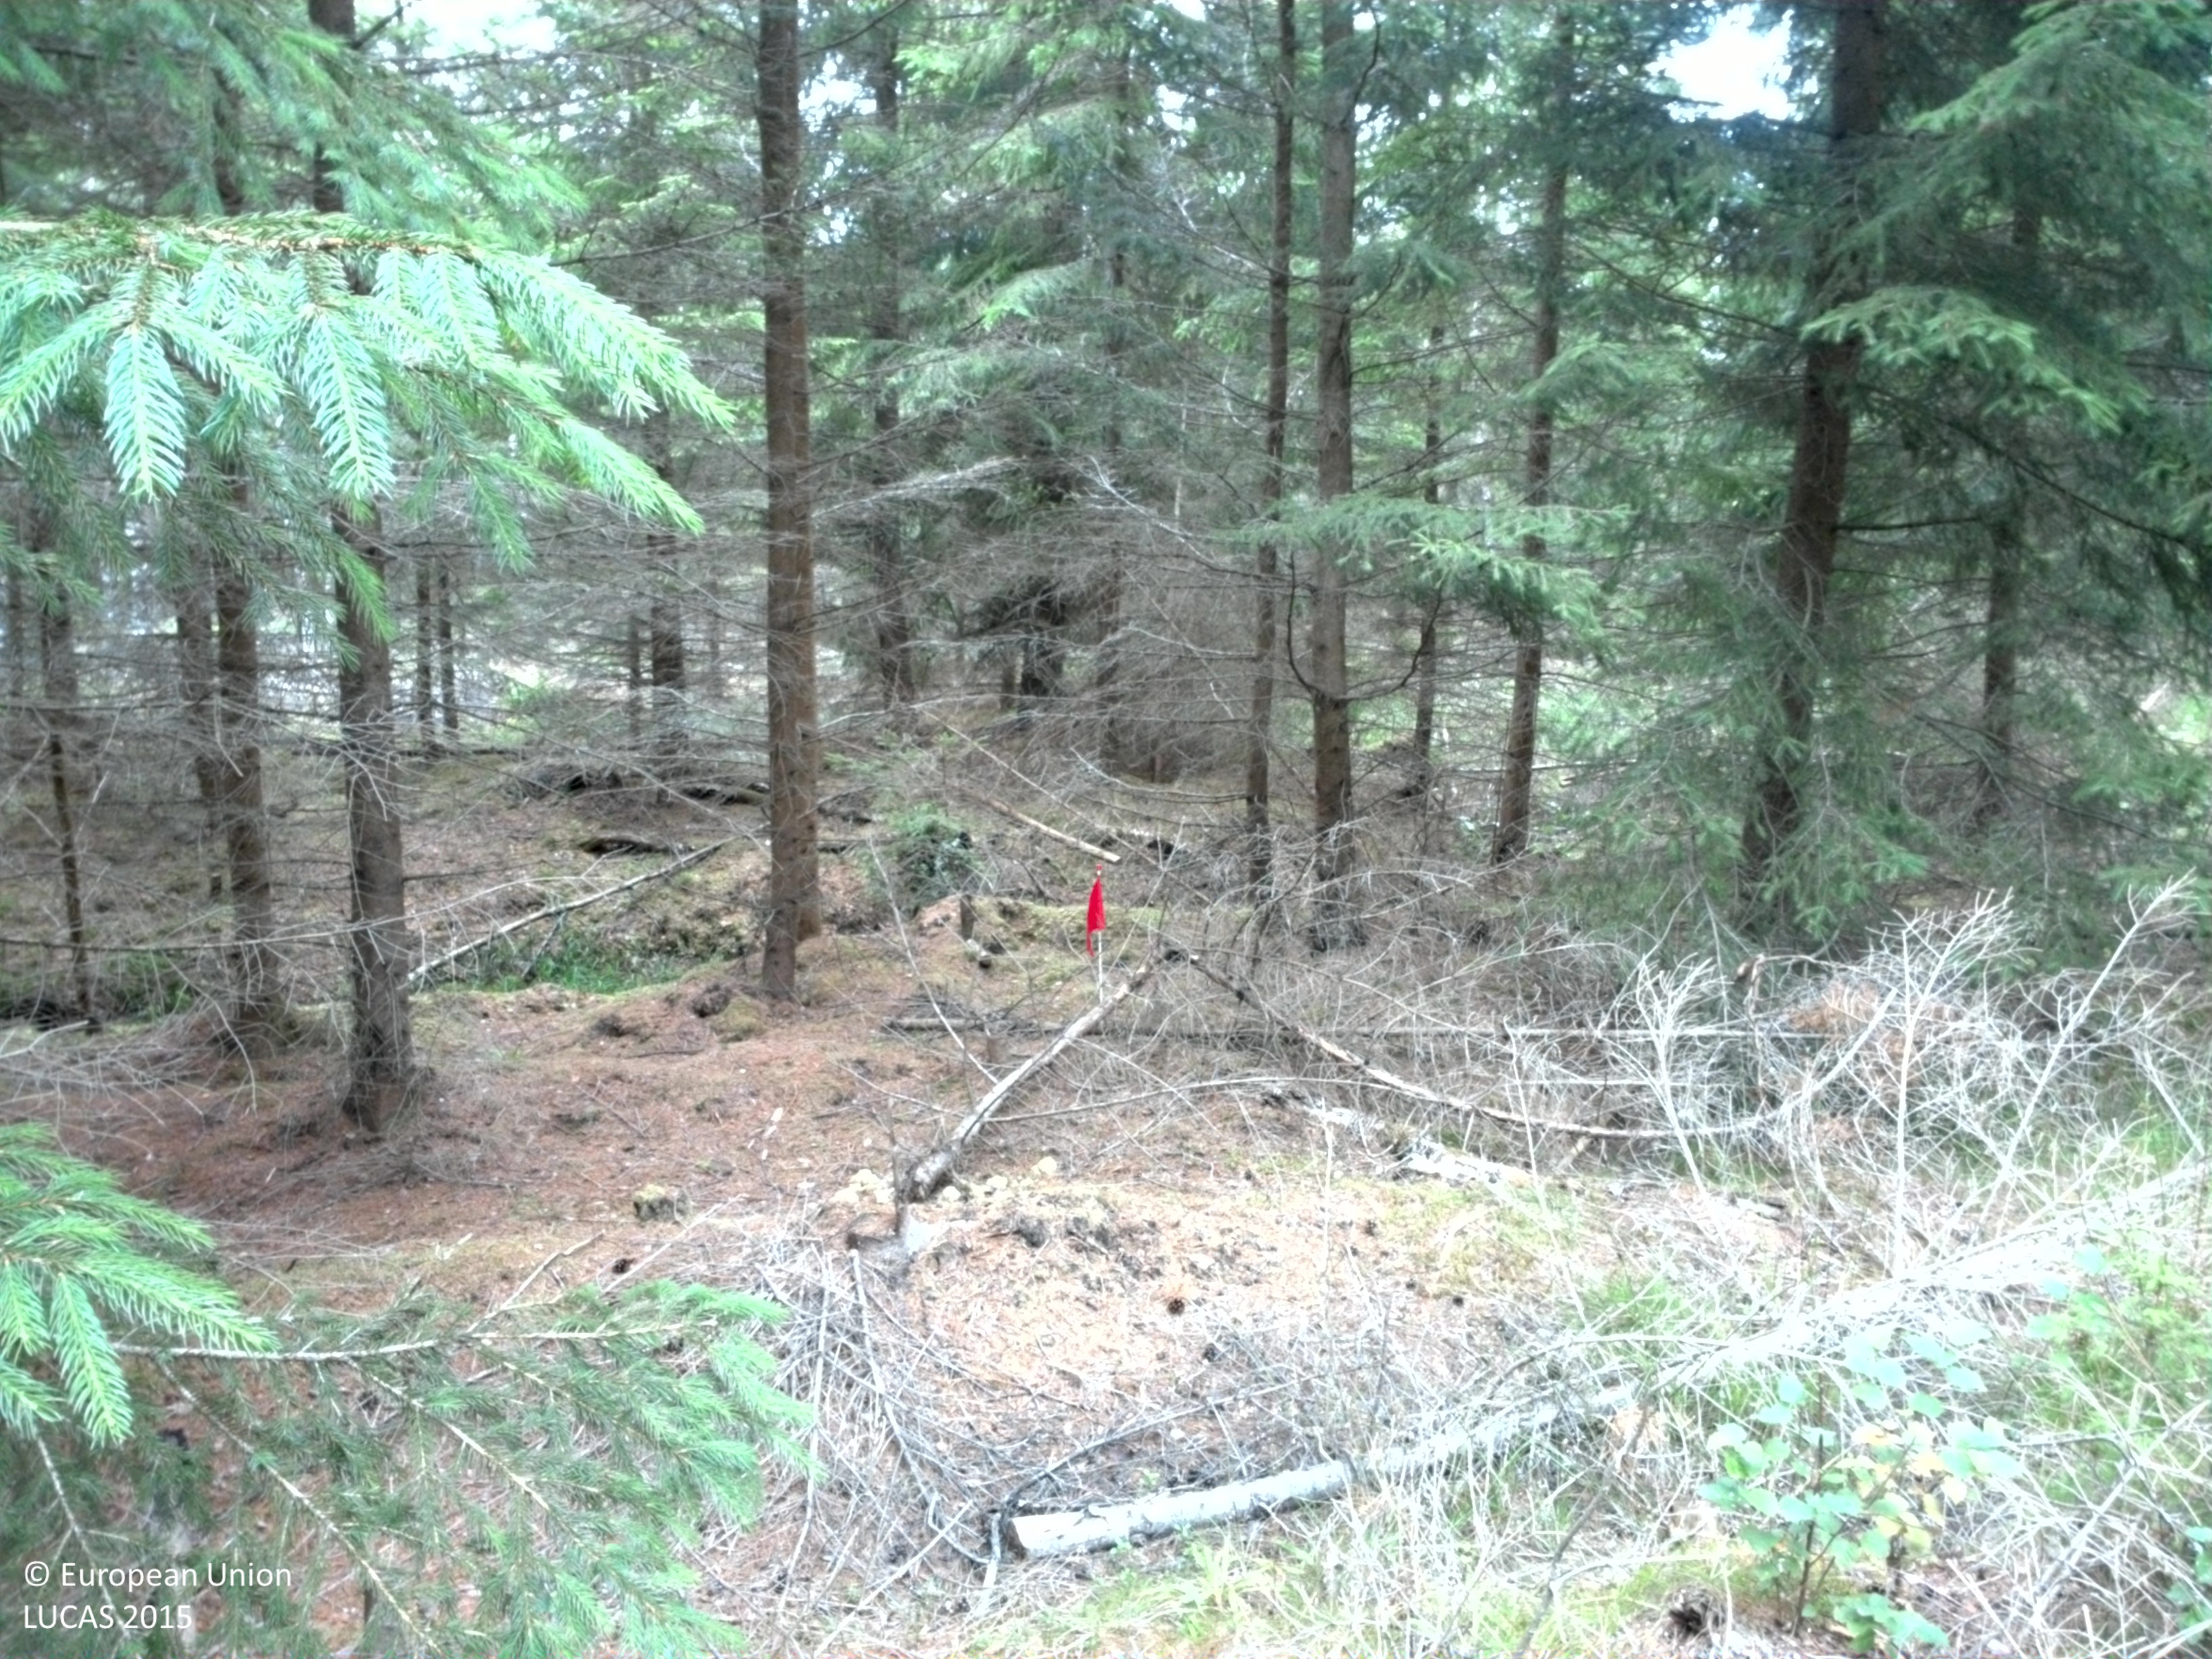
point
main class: Woodland
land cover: Spruce dominated coniferous woodland
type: boreal forest
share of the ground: > 75 %
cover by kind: coniferous forest trees 85 %, unconsolidated bare surface 10 %, lichens and mosses 5 %
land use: Forestry
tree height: > 5 m
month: July
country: SE
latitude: 58.3592
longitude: 13.2928
